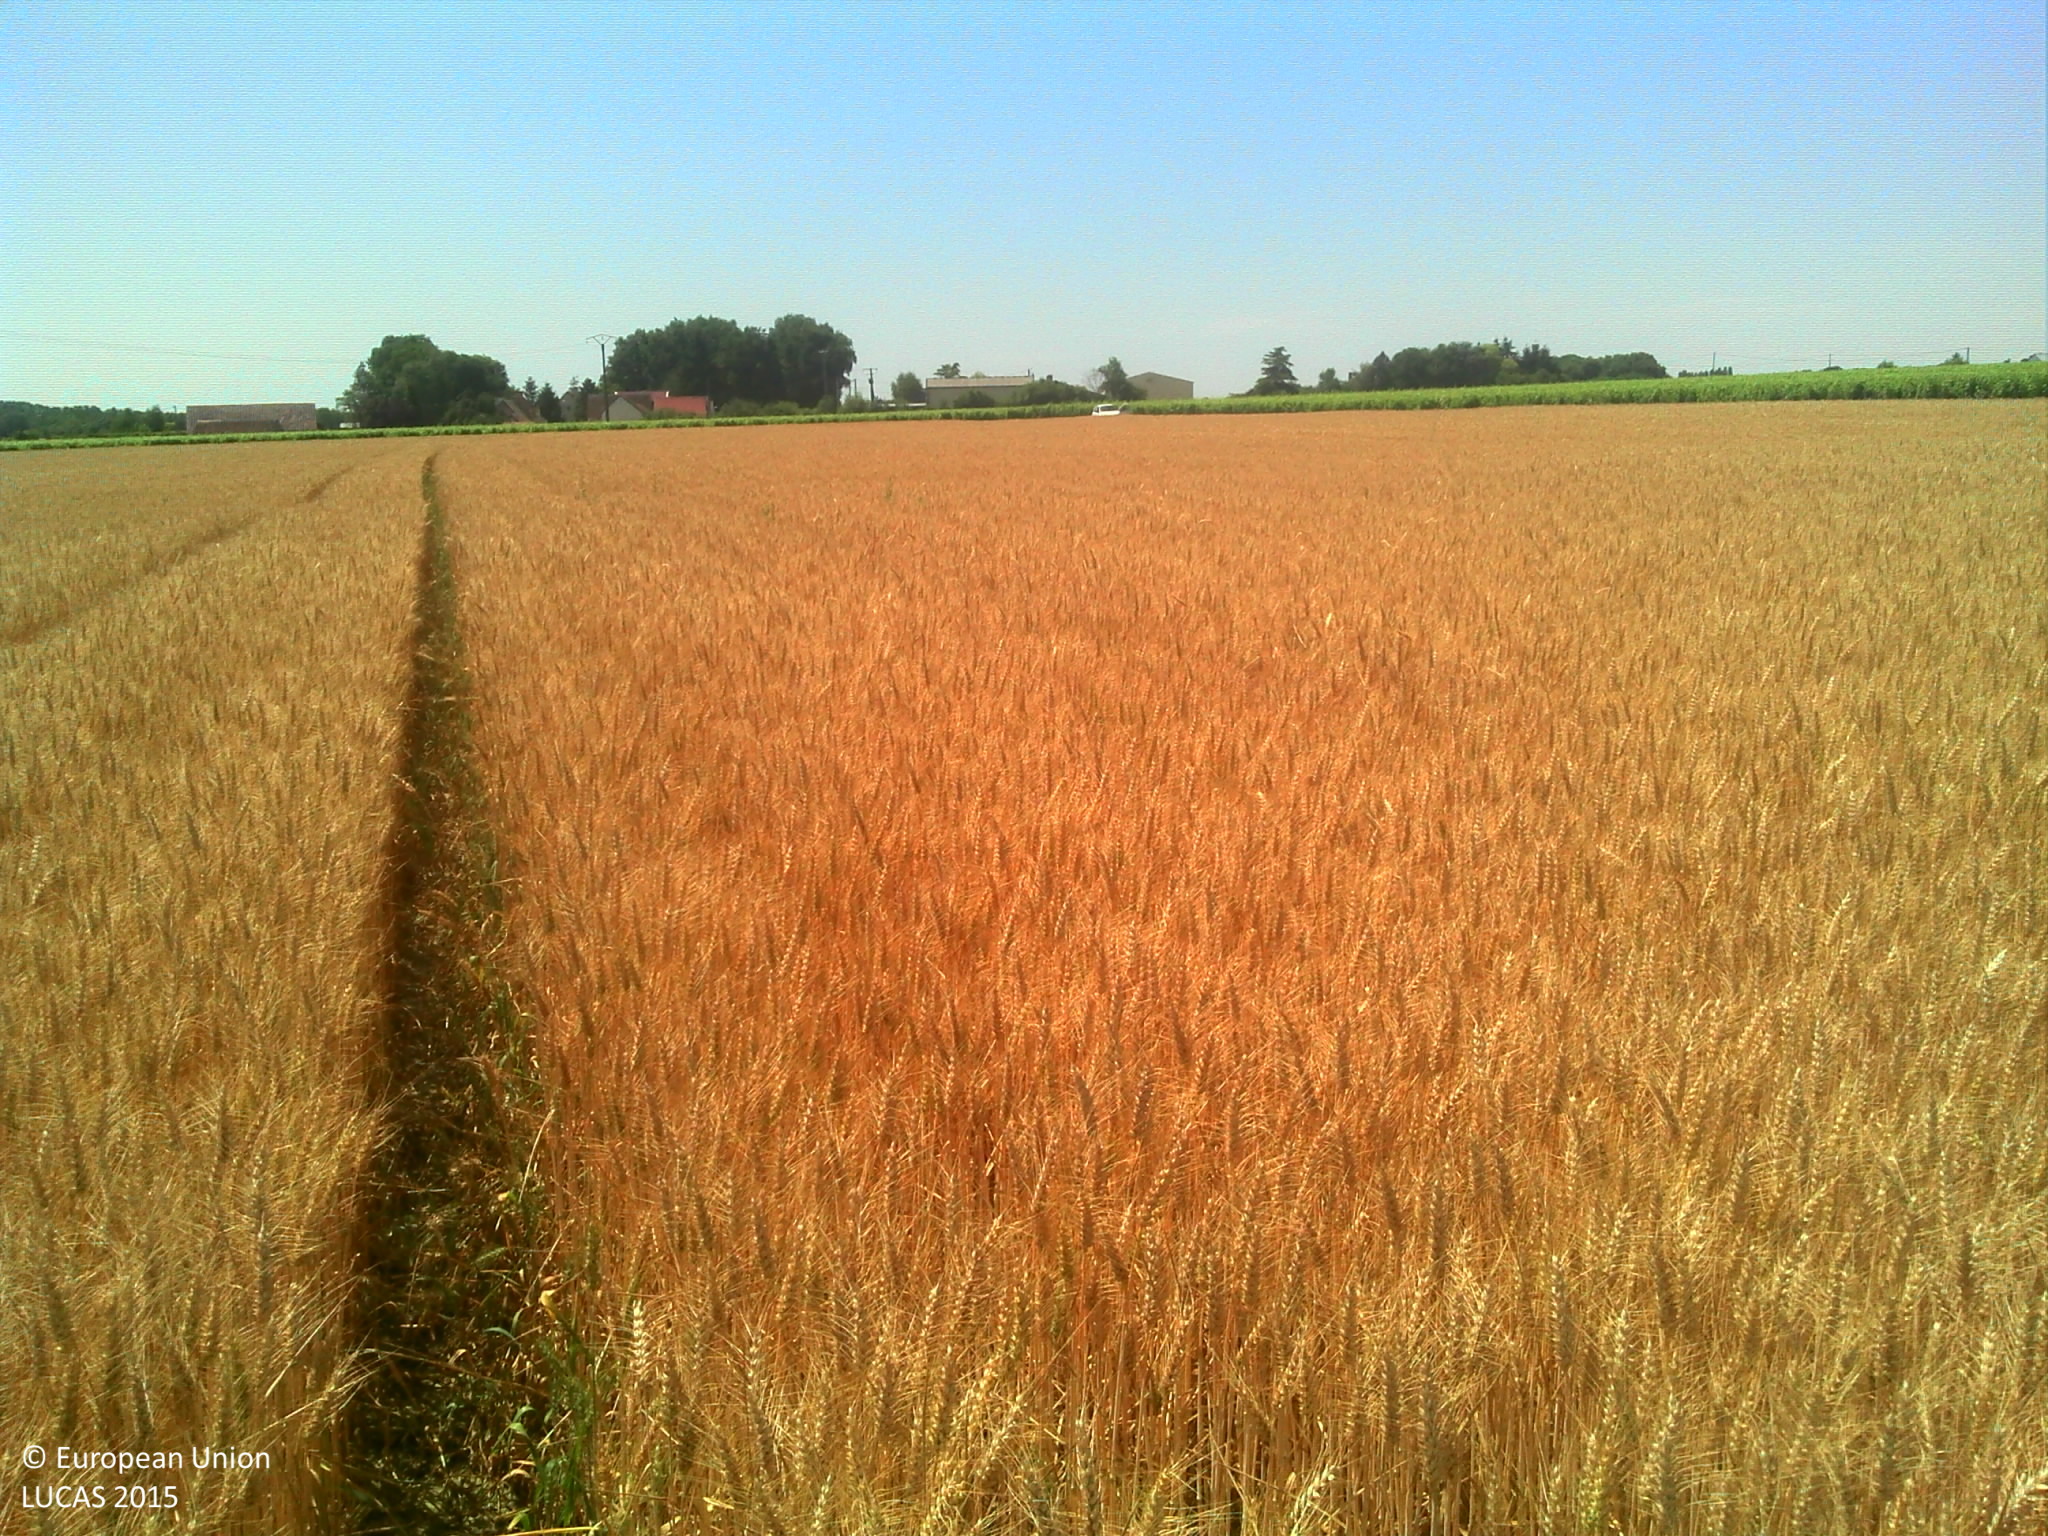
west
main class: Cropland
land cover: Durum wheat
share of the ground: > 75 %
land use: Agriculture (excluding fallow land and kitchen gardens)
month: June
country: FR
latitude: 47.3952
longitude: 1.3605
